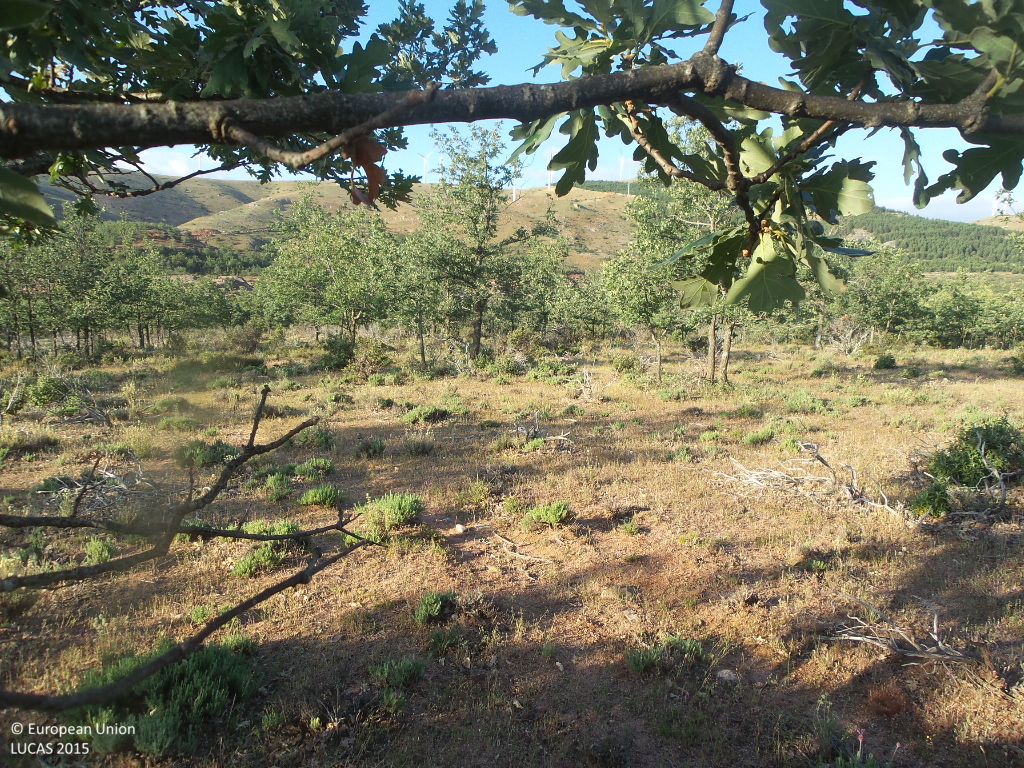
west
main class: Woodland
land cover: Broadleaved woodland
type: thermophilous deciduous forest
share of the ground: 50 - 75 %
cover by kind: broadleaved forest trees 50 %, shrubs 15 %, herbaceous plants 15 %, unconsolidated bare surface 15 %, lichens and mosses 5 %
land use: Semi-natural and natural areas not in use
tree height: < 5 m
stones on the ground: < 10 %
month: June
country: ES
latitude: 41.3032
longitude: -3.1188
